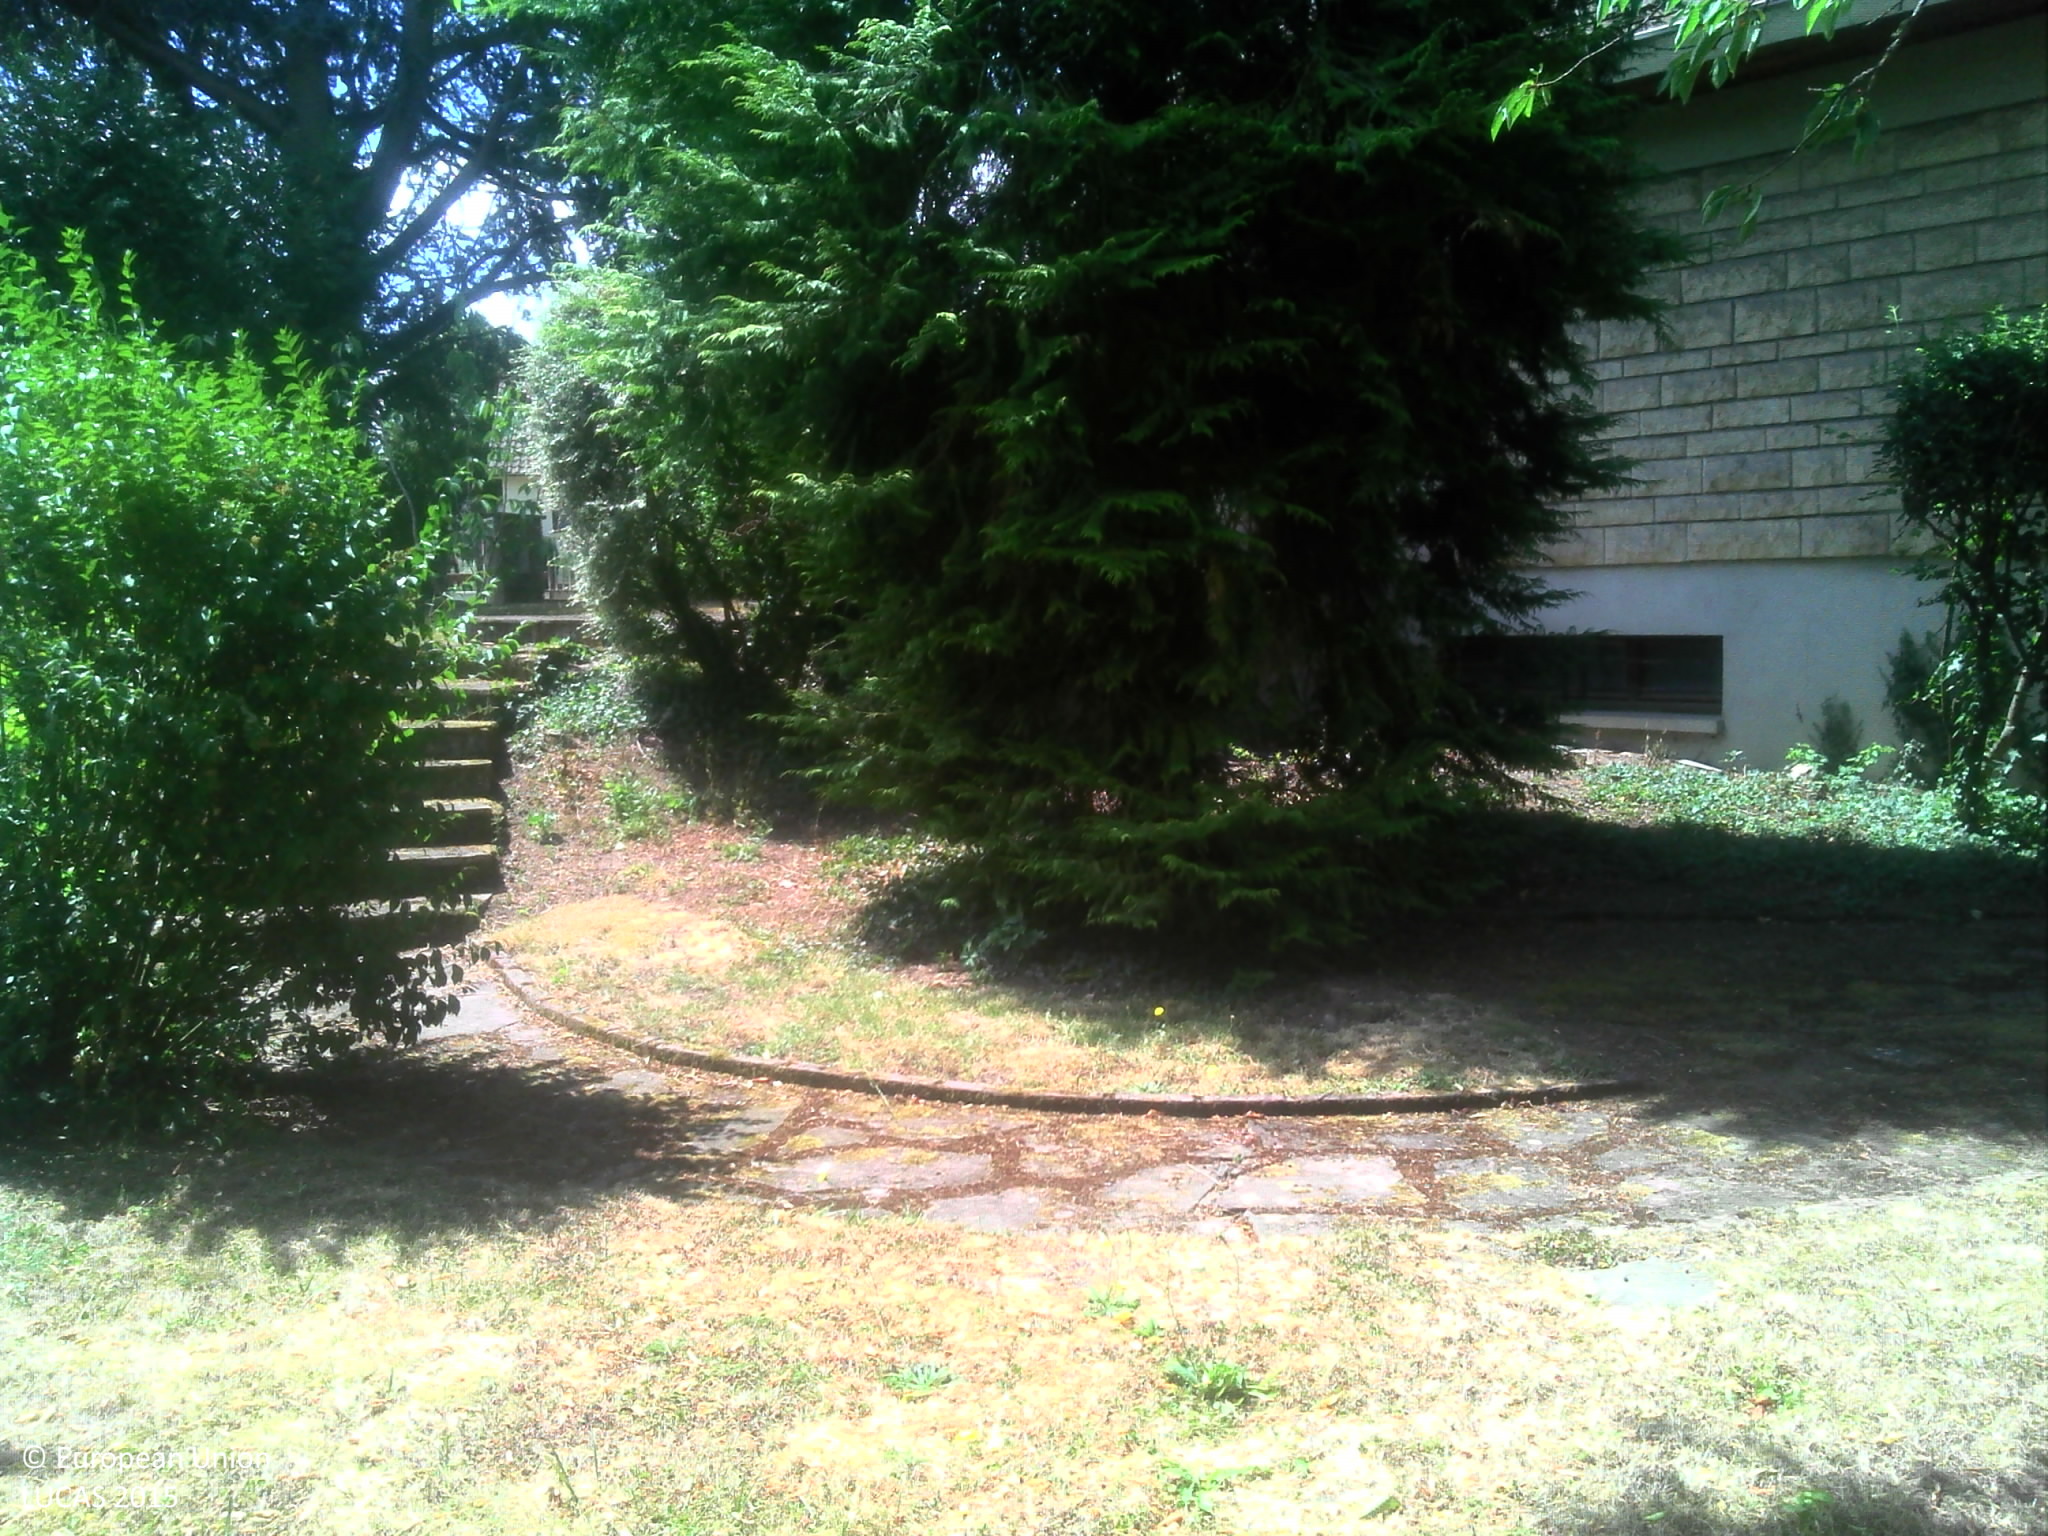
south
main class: Grassland
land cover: Grassland with sparse tree/shrub cover
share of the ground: > 75 %
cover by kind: herbaceous plants 95 %, coniferous forest trees 5 %
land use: Residential
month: July
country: FR
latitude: 48.4713
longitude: 1.0118
